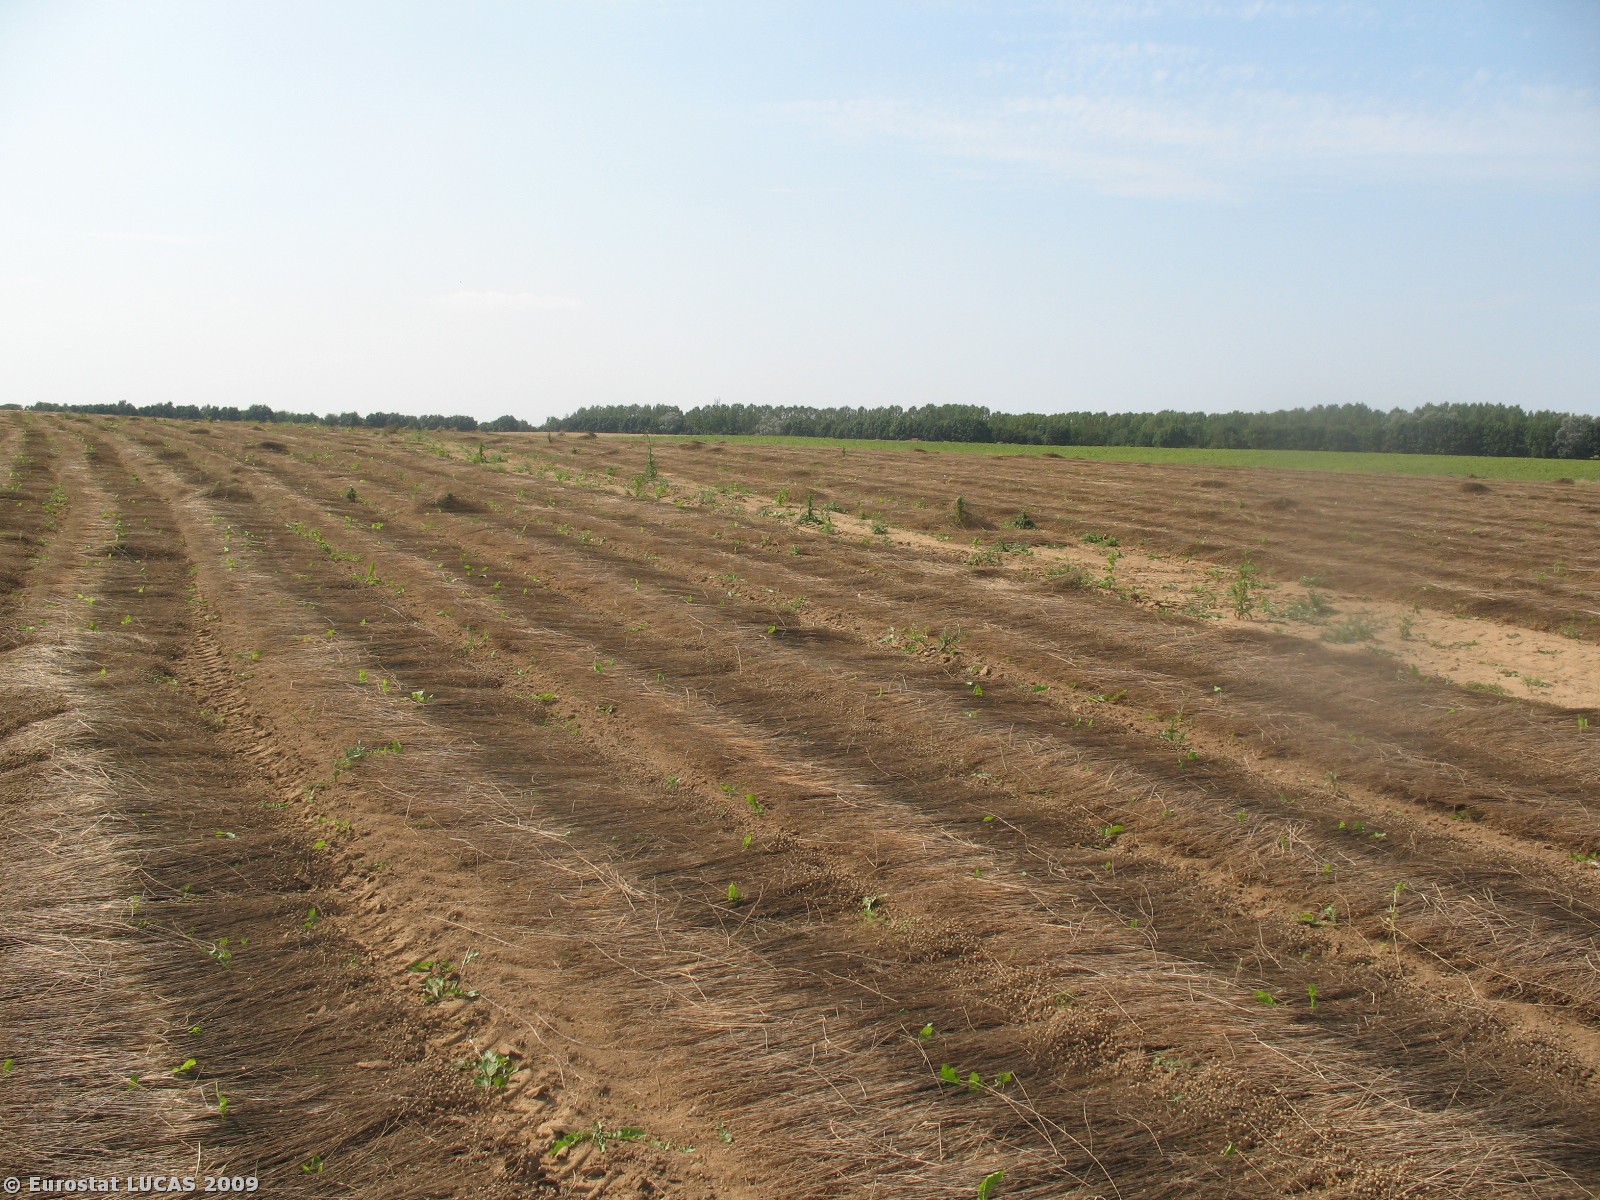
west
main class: Cropland
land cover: Other fibre and oleaginous crops
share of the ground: > 75 %
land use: Agriculture (excluding fallow land and kitchen gardens)
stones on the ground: < 10 %
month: August
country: BE
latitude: 50.6557
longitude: 4.3231
